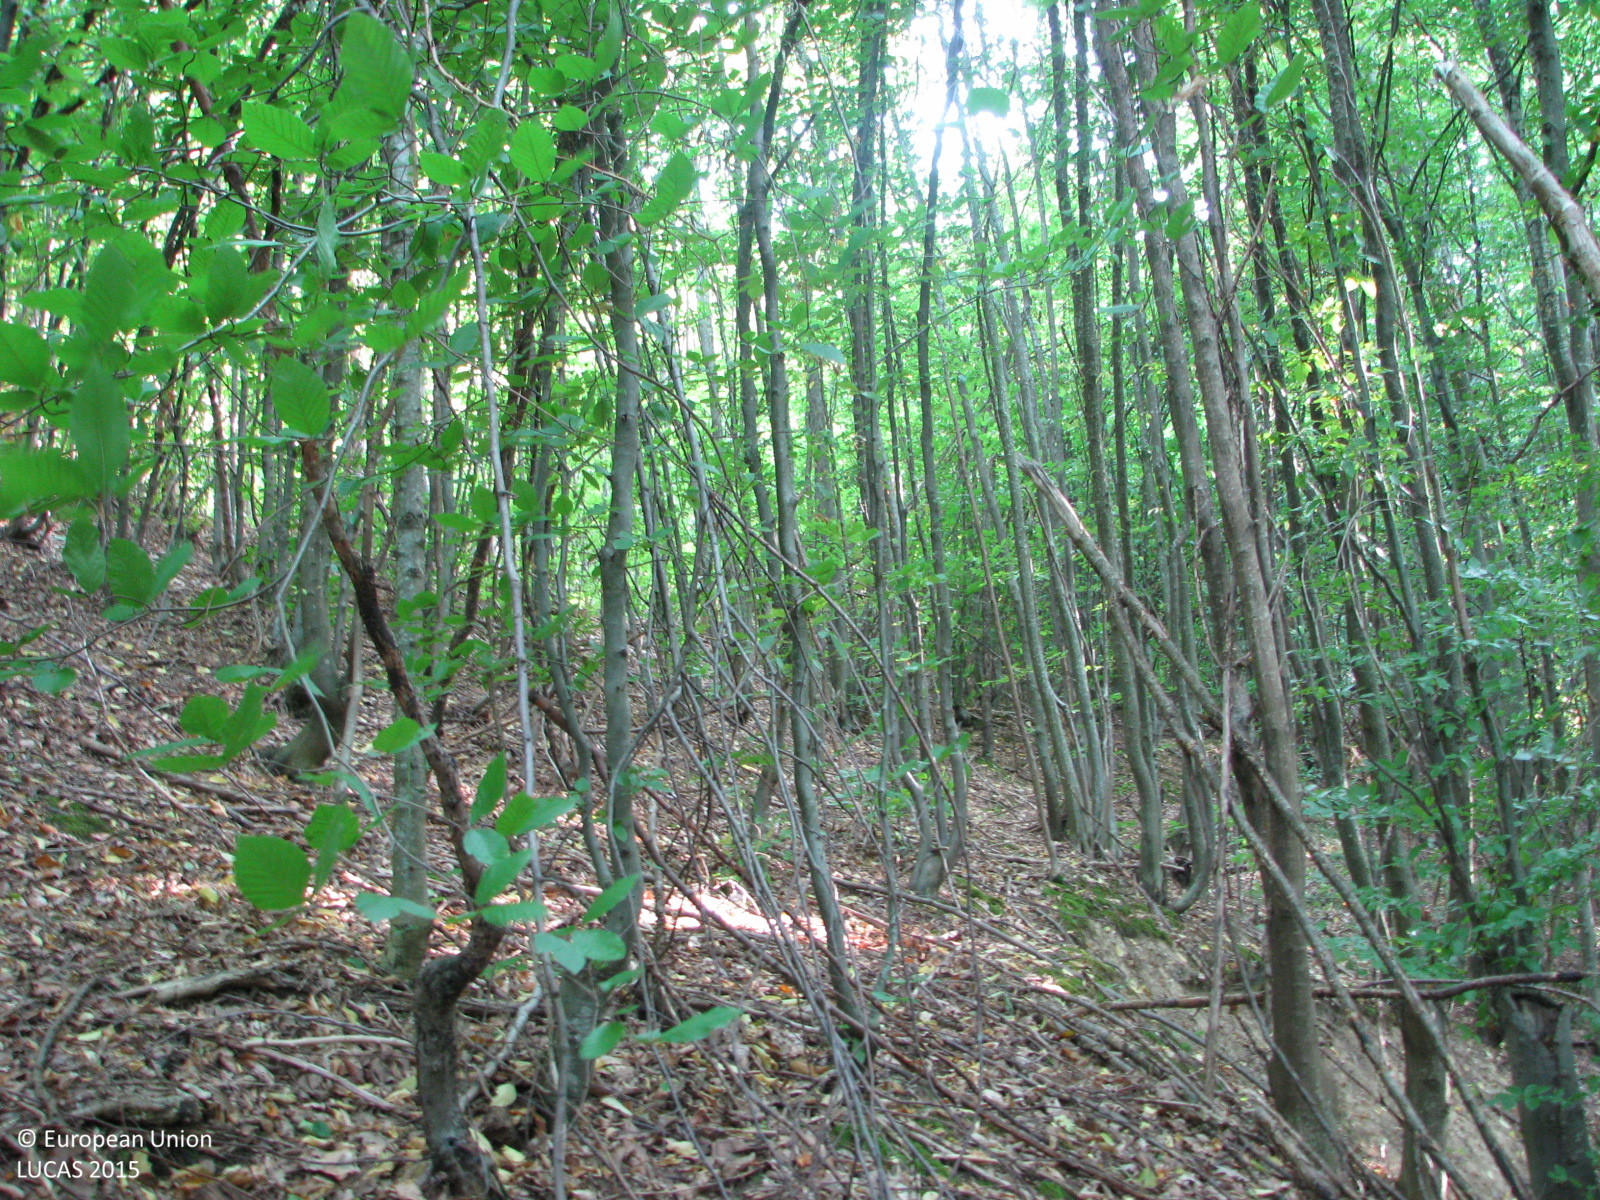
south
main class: Woodland
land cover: Broadleaved woodland
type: beech forest
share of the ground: 50 - 75 %
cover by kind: broadleaved forest trees 60 %, consolidated bare surface 25 %, shrubs 10 %, herbaceous plants 5 %
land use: Forestry
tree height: > 5 m
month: August
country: BG
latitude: 42.8791
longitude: 26.1138
